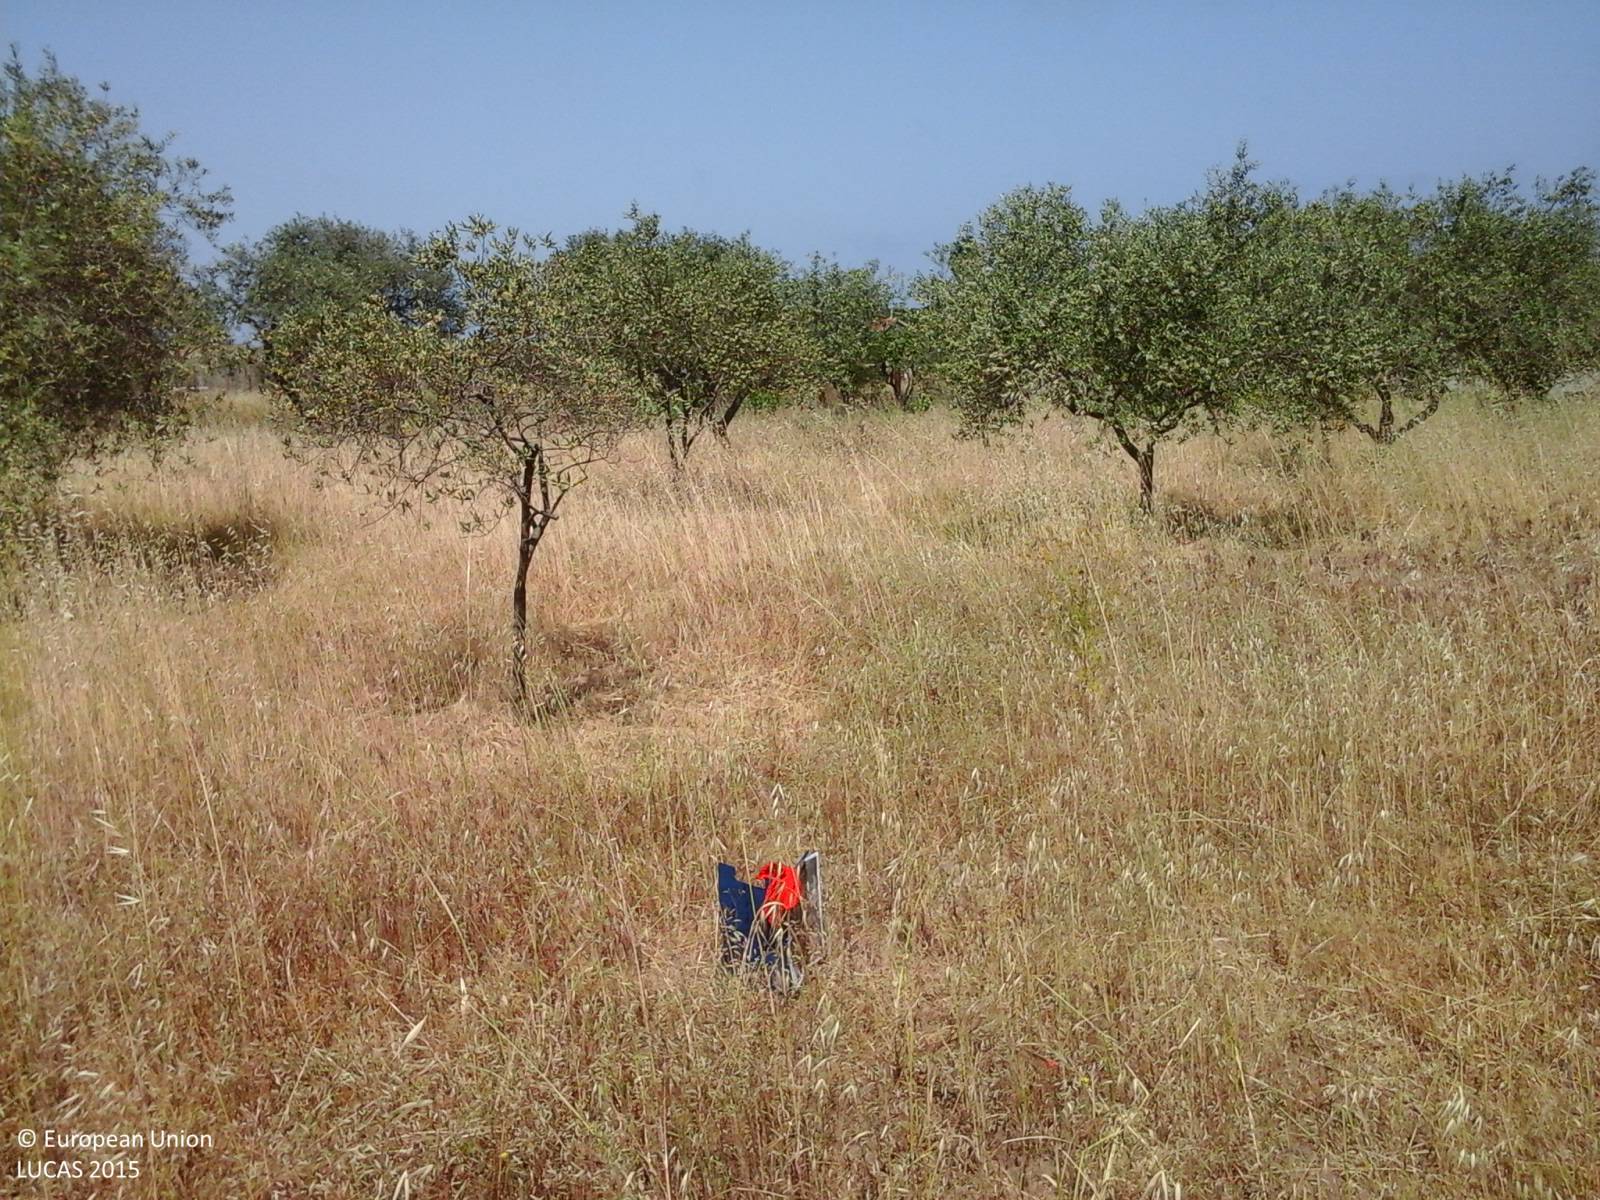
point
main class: Cropland
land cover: Olive groves
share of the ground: 25 - 50 %
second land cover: Spontaneously vegetated surfaces
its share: > 75 %
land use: Agriculture (excluding fallow land and kitchen gardens)
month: May
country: IT
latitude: 40.8180
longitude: 8.5722
